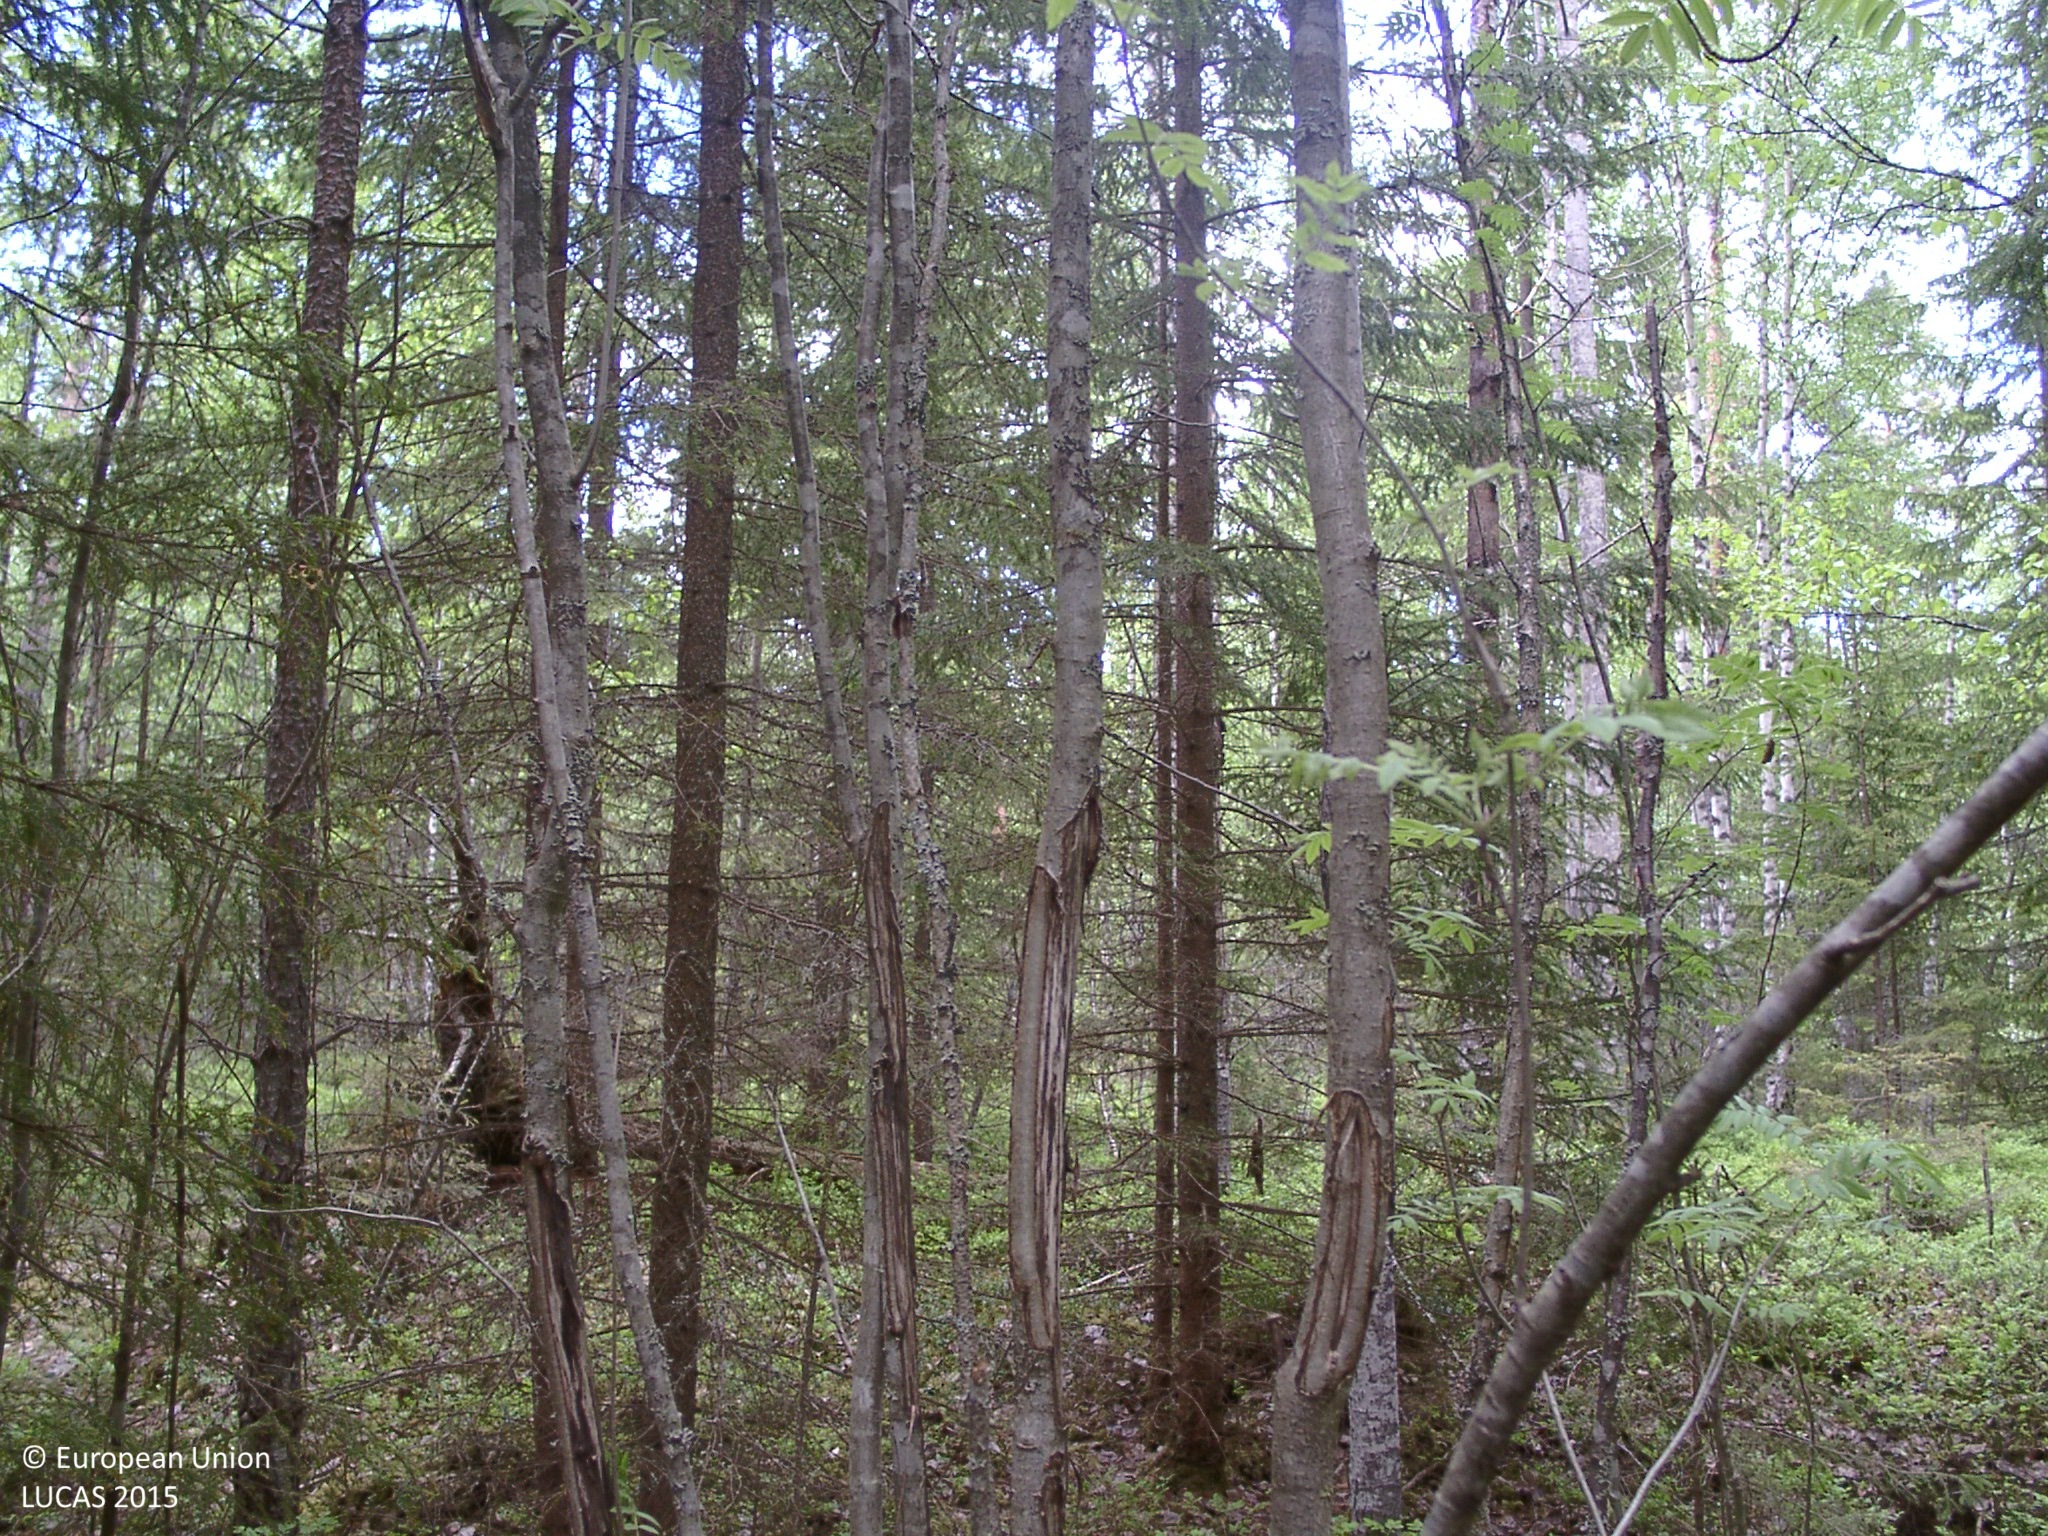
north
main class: Woodland
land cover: Spruce dominated mixed woodland
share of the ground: > 75 %
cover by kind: broadleaved forest trees 45 %, coniferous forest trees 35 %, shrubs 15 %, lichens and mosses 5 %
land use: Semi-natural and natural areas not in use
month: June
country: FI
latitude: 62.1327
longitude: 25.5150
